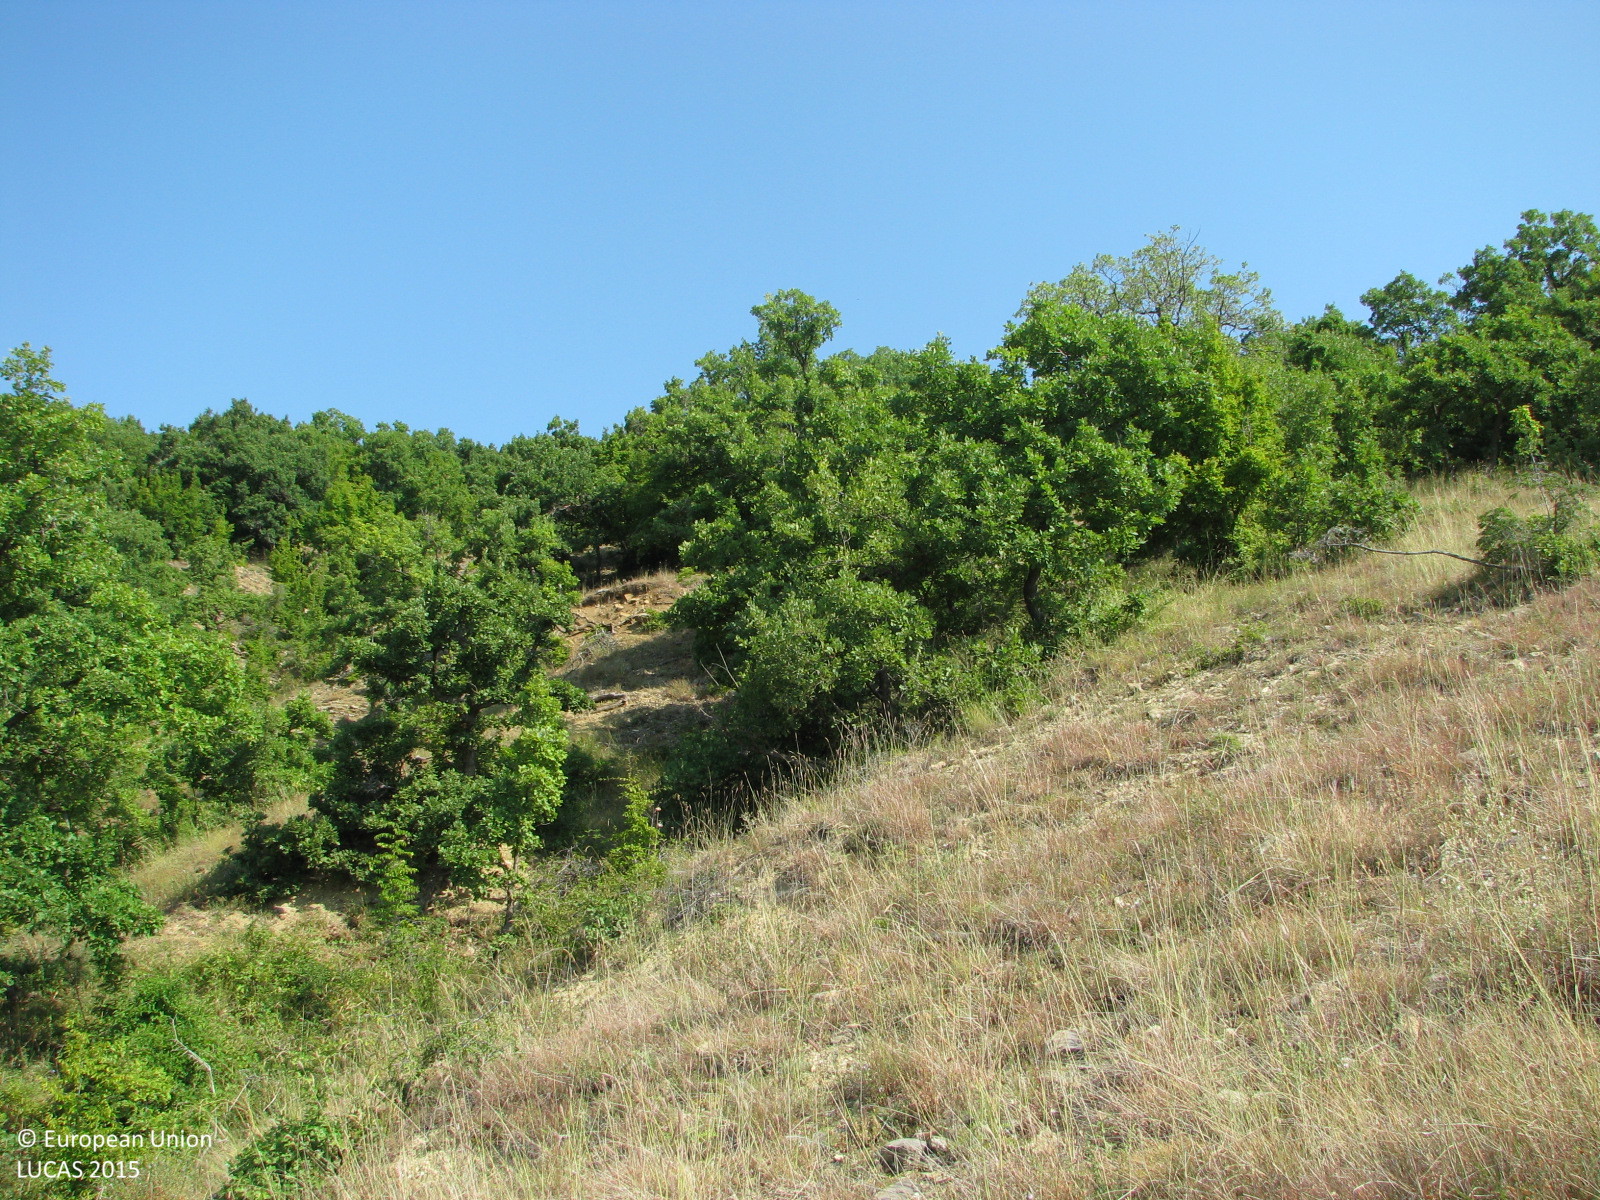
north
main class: Grassland
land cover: Grassland with sparse tree/shrub cover
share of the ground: > 75 %
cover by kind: herbaceous plants 90 %, broadleaved forest trees 5 %, shrubs 5 %
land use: Agriculture (excluding fallow land and kitchen gardens)
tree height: > 5 m
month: July
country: BG
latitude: 42.6741
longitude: 26.1321
